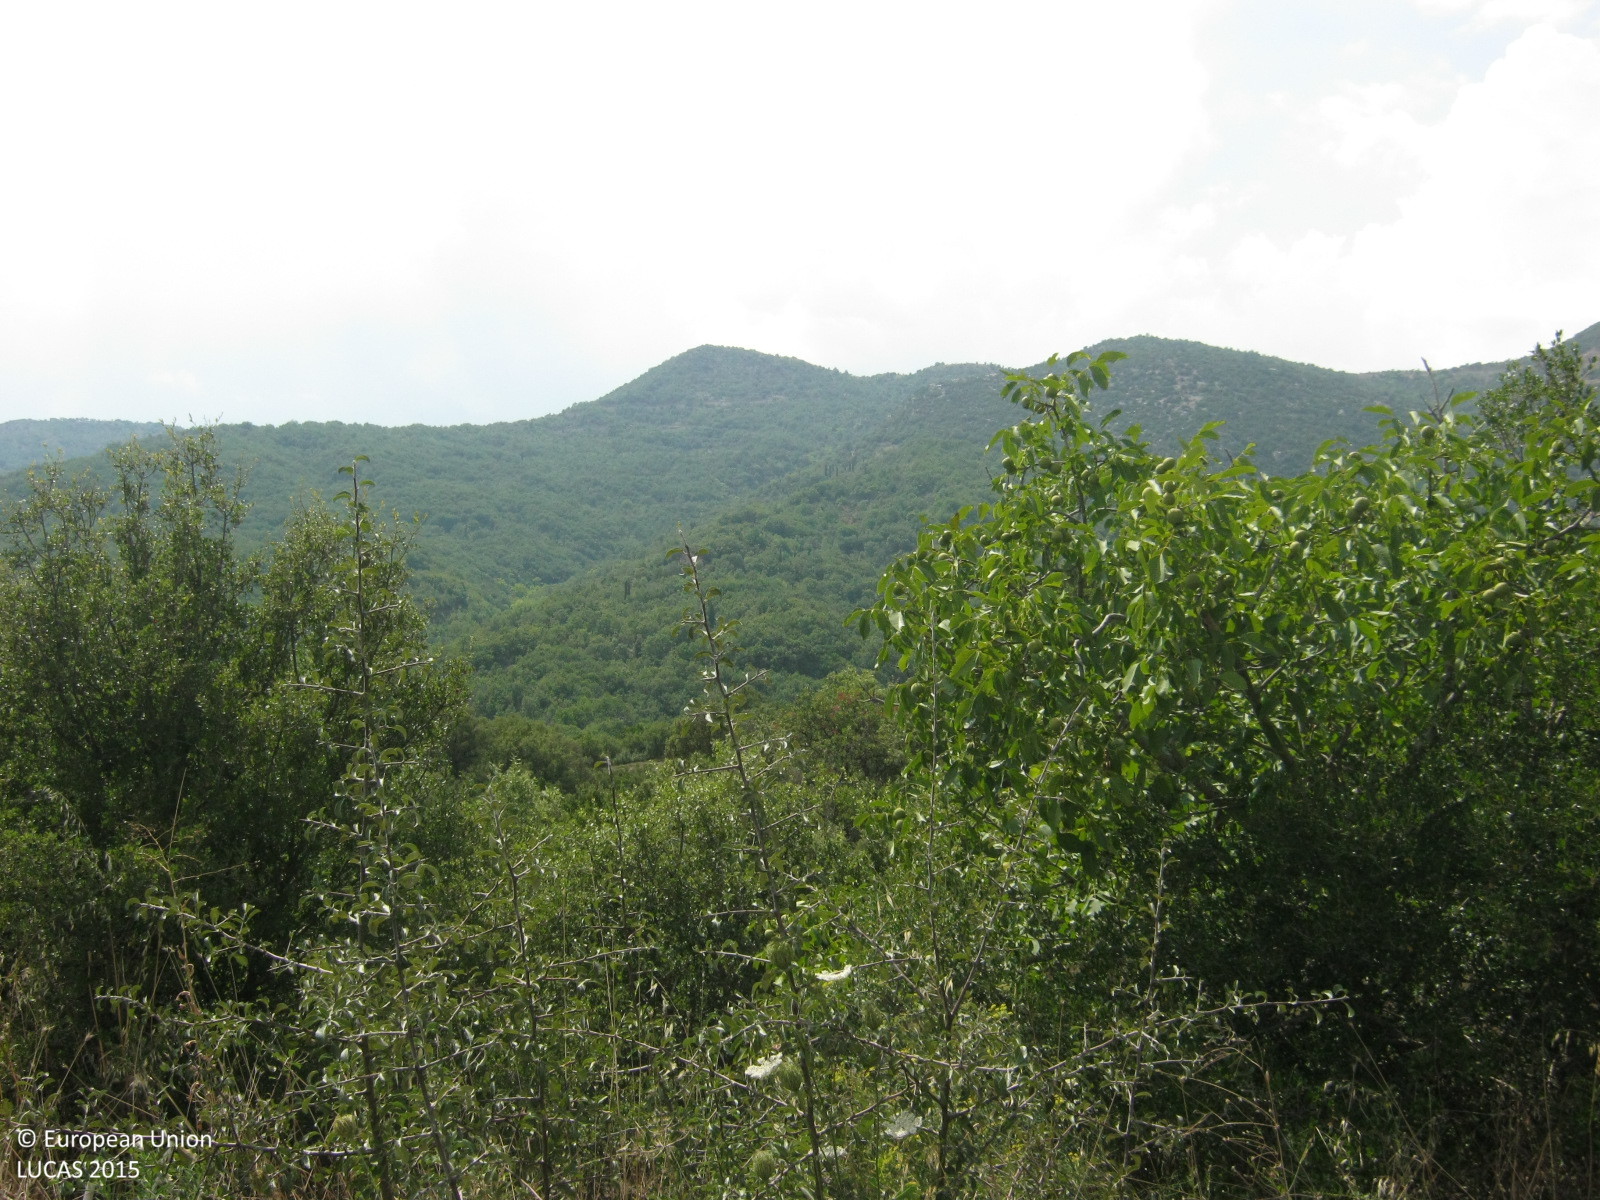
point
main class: Woodland
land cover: Broadleaved woodland
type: thermophilous deciduous forest
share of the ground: > 75 %
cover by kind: broadleaved forest trees 90 %, shrubs 5 %, herbaceous plants 5 %
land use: Forestry
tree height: > 5 m
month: August
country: GR
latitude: 37.4044
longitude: 22.0121
